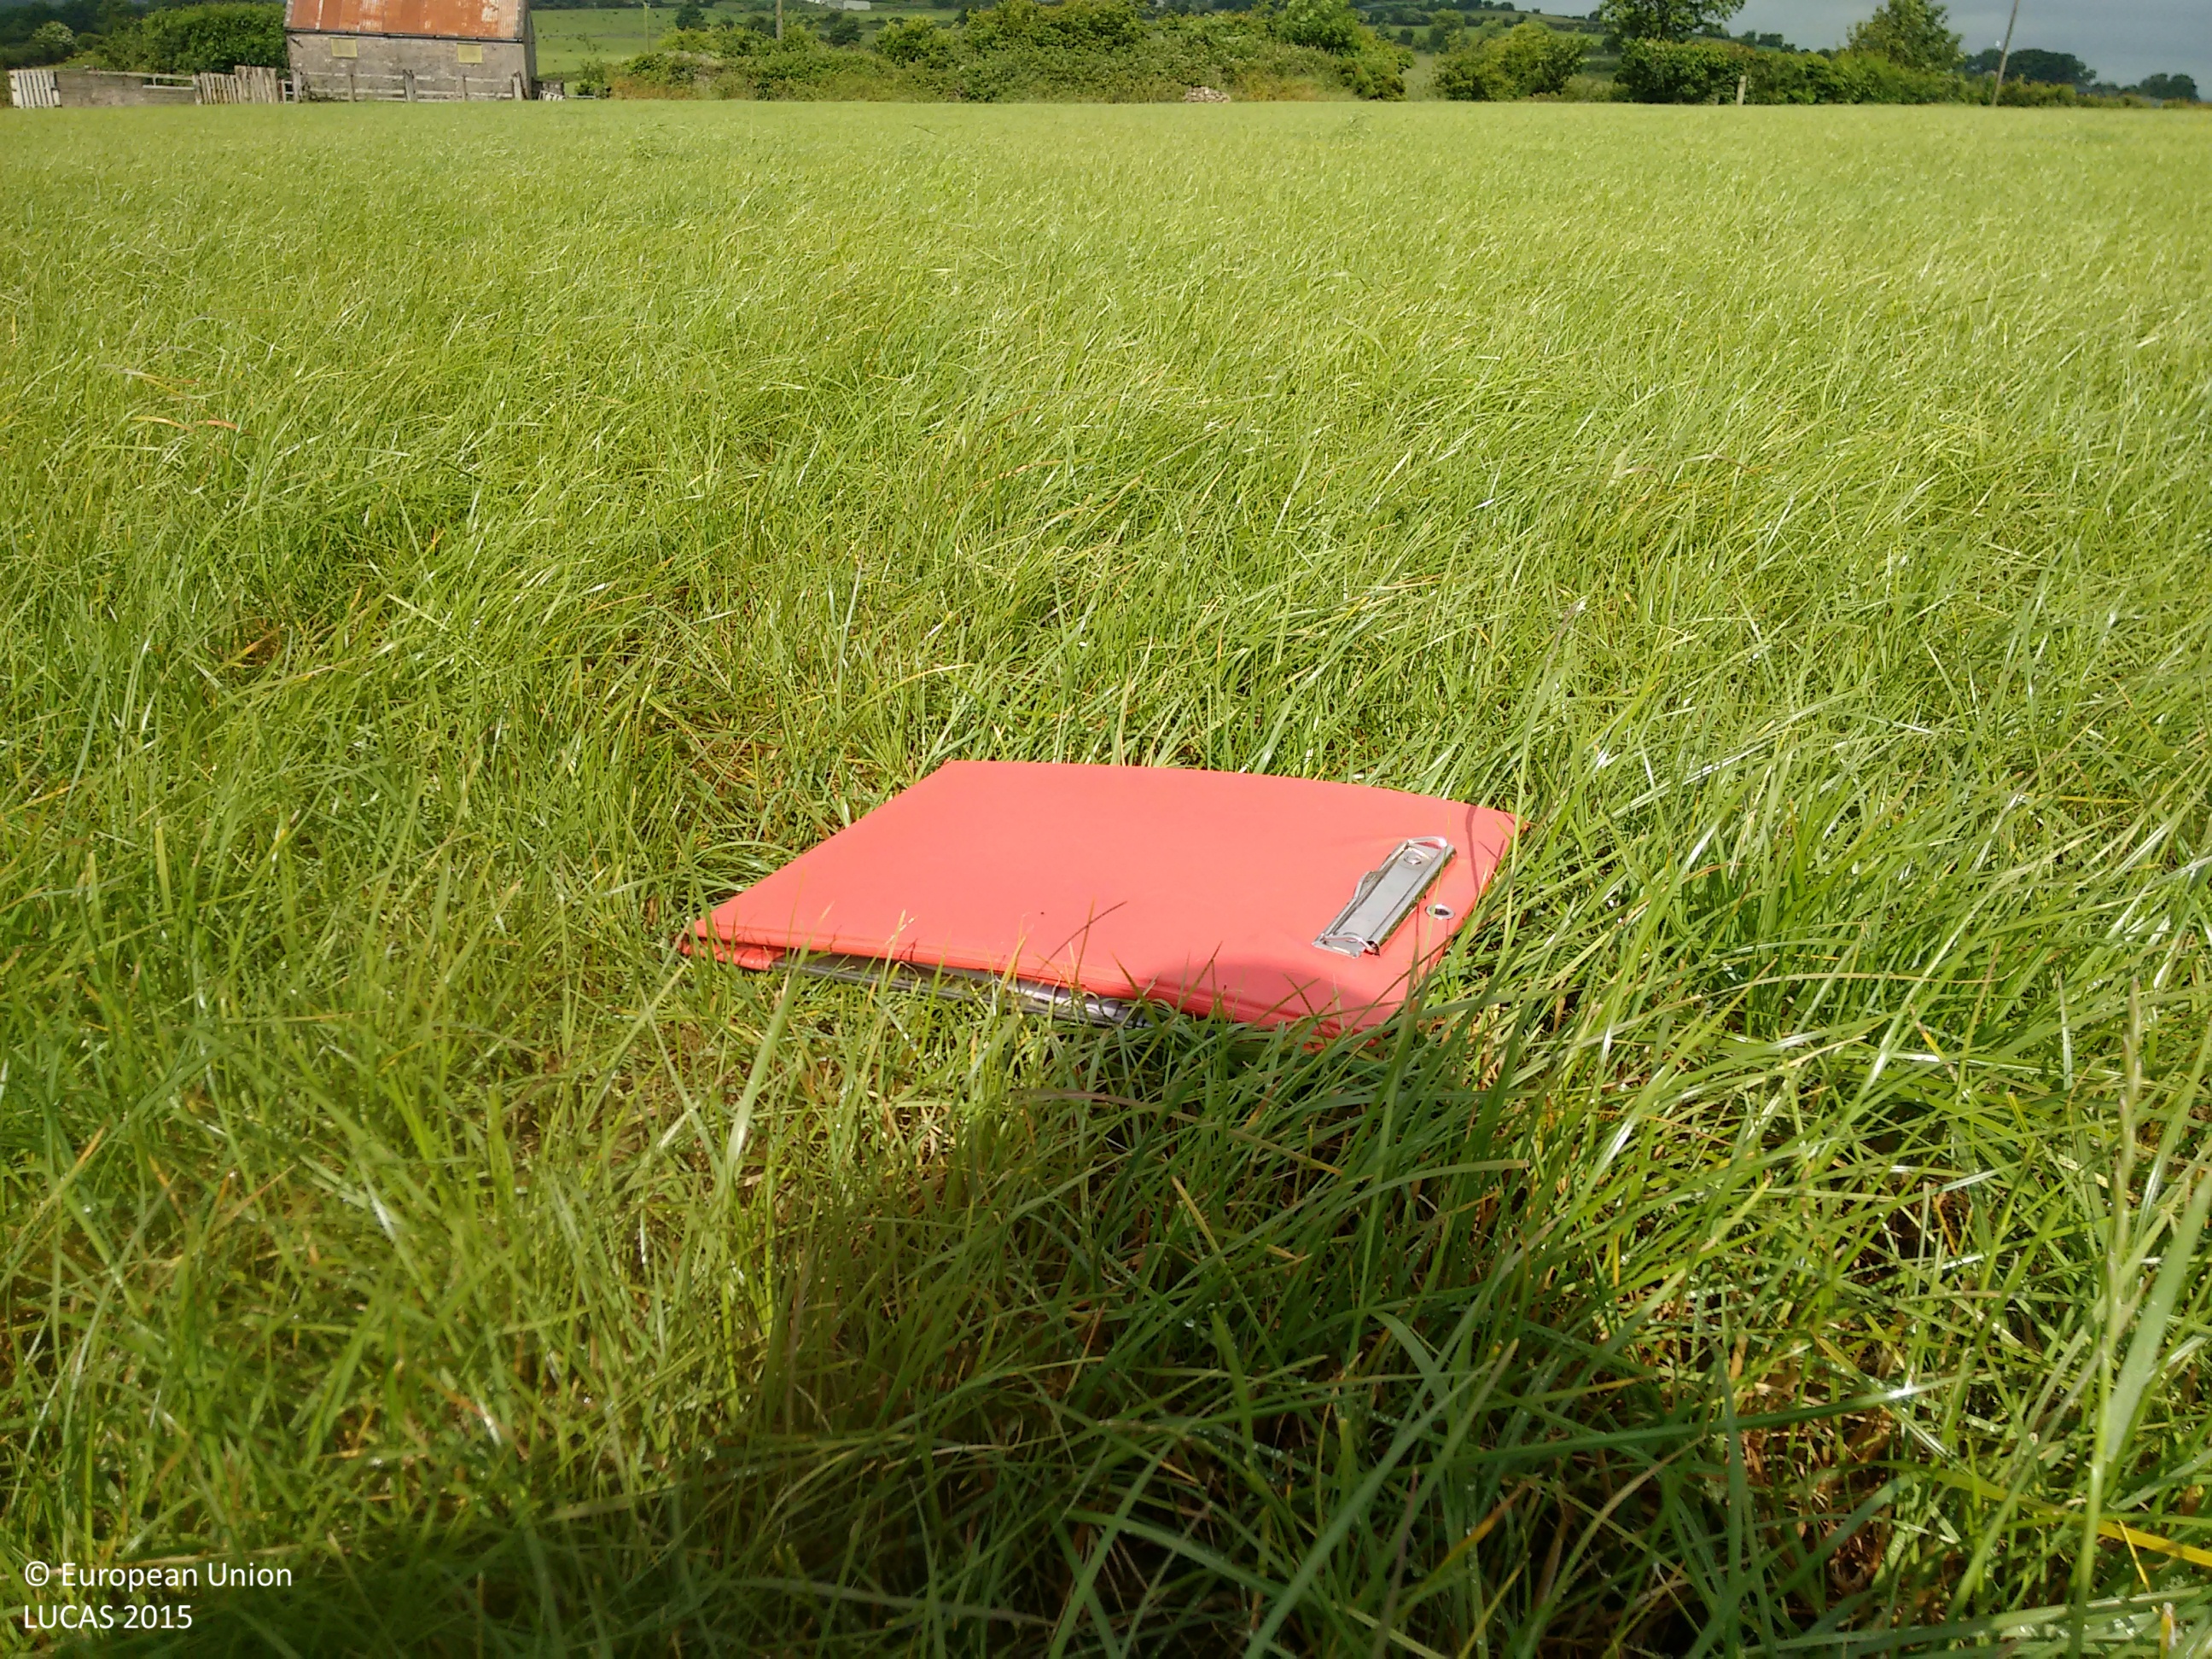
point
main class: Grassland
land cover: Grassland without tree/shrub cover
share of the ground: > 75 %
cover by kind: herbaceous plants 100 %
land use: Agriculture (excluding fallow land and kitchen gardens)
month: June
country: IE
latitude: 52.1262
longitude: -8.1328
